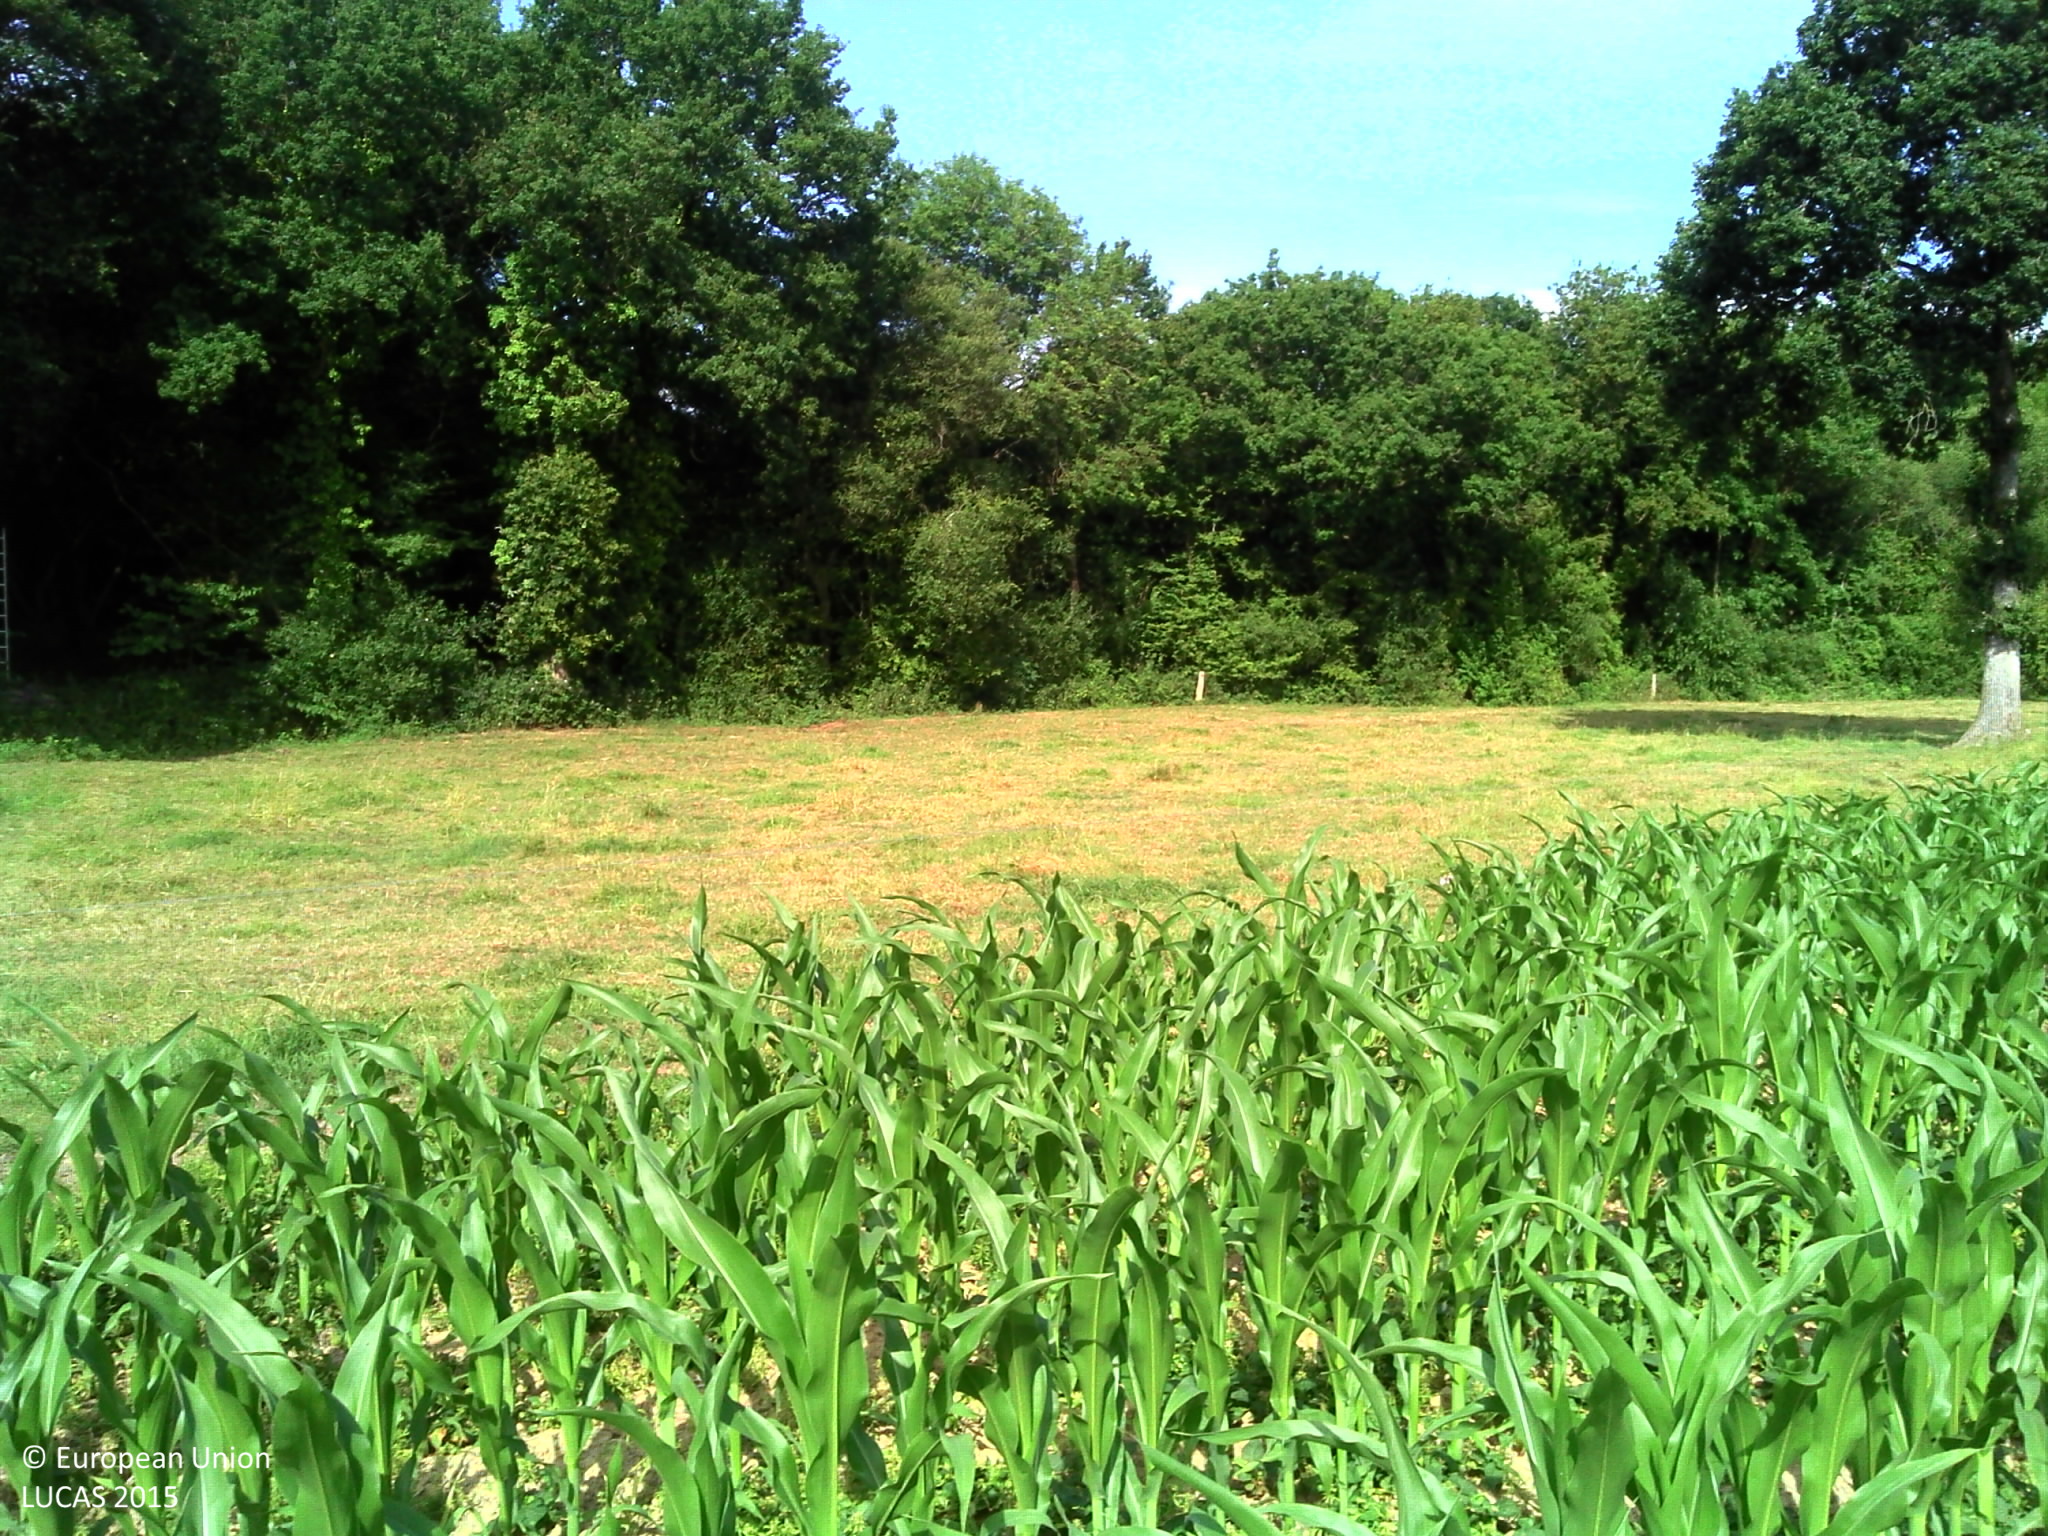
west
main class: Cropland
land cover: Maize
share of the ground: > 75 %
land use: Agriculture (excluding fallow land and kitchen gardens)
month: June
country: FR
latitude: 47.9612
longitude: -2.0388
